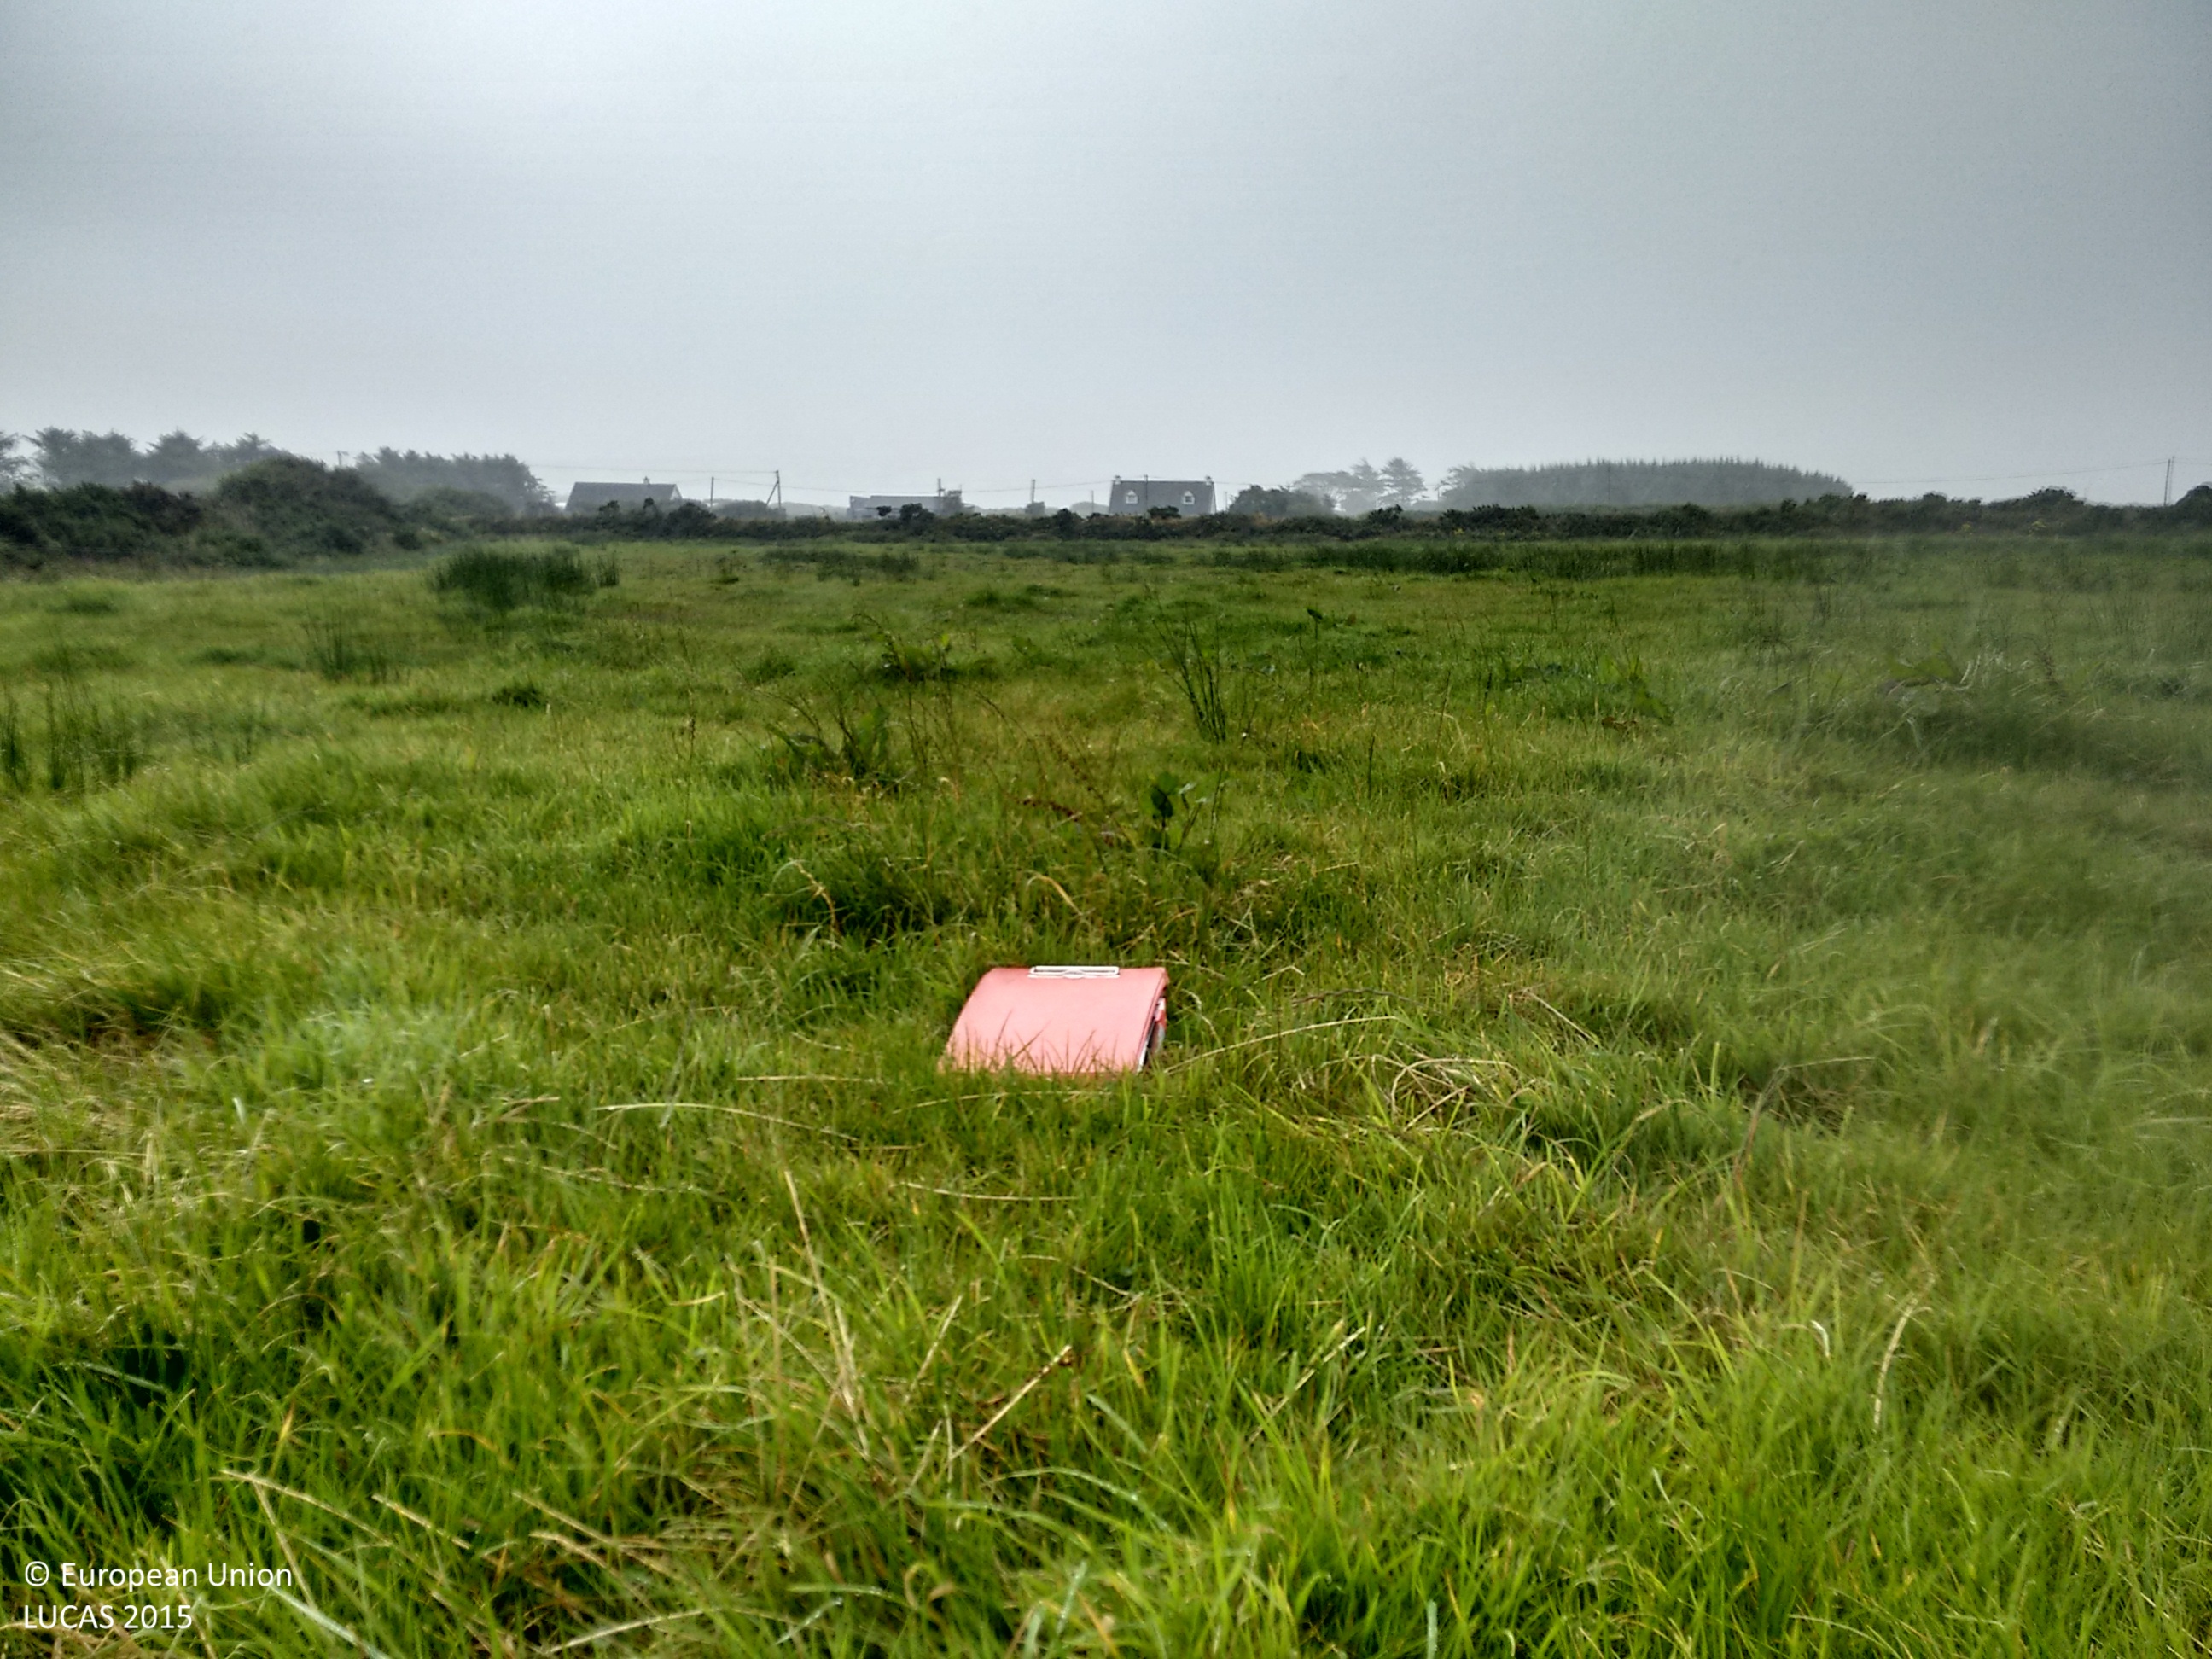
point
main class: Grassland
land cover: Grassland without tree/shrub cover
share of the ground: > 75 %
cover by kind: herbaceous plants 95 %, shrubs 5 %
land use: Agriculture (excluding fallow land and kitchen gardens)
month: August
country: IE
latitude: 51.9065
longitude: -10.3425
